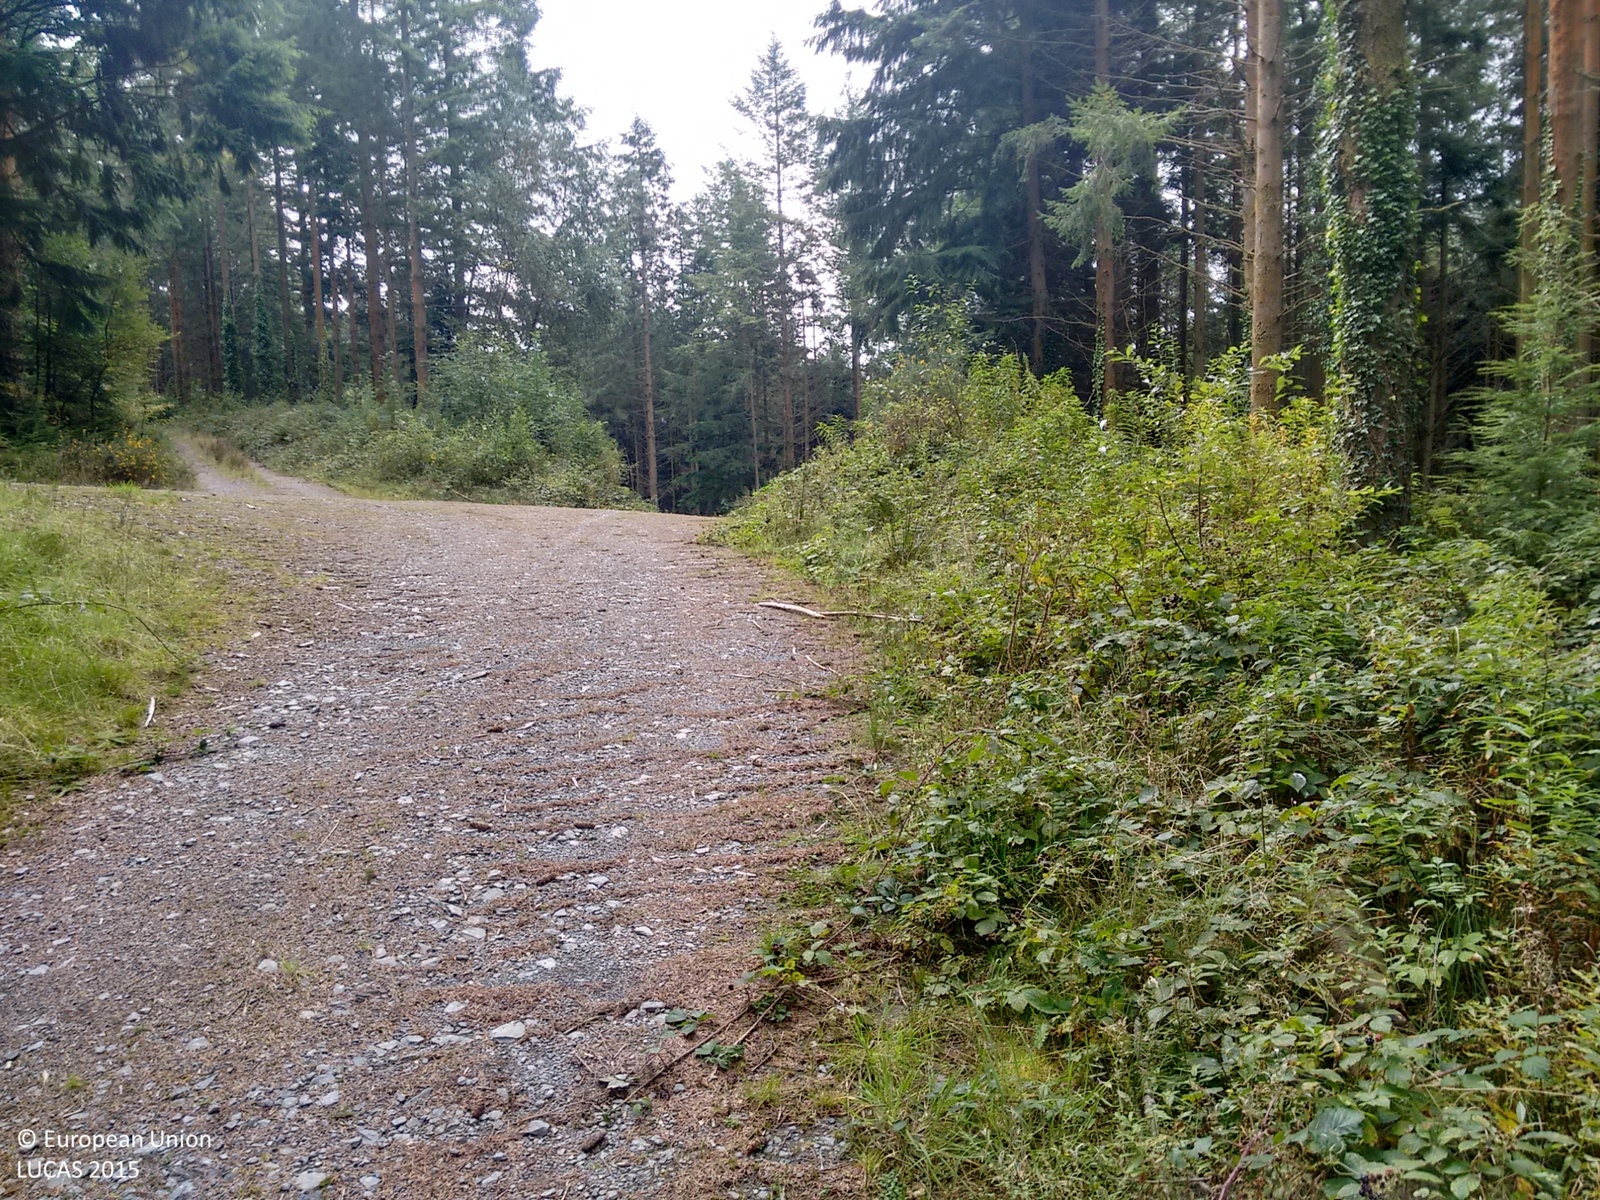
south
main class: Woodland
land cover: Other coniferous woodland
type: exotic forest
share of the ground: > 75 %
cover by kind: coniferous forest trees 100 %
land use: Forestry
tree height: > 5 m
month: September
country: GB
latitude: 52.6897
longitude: -3.7144
